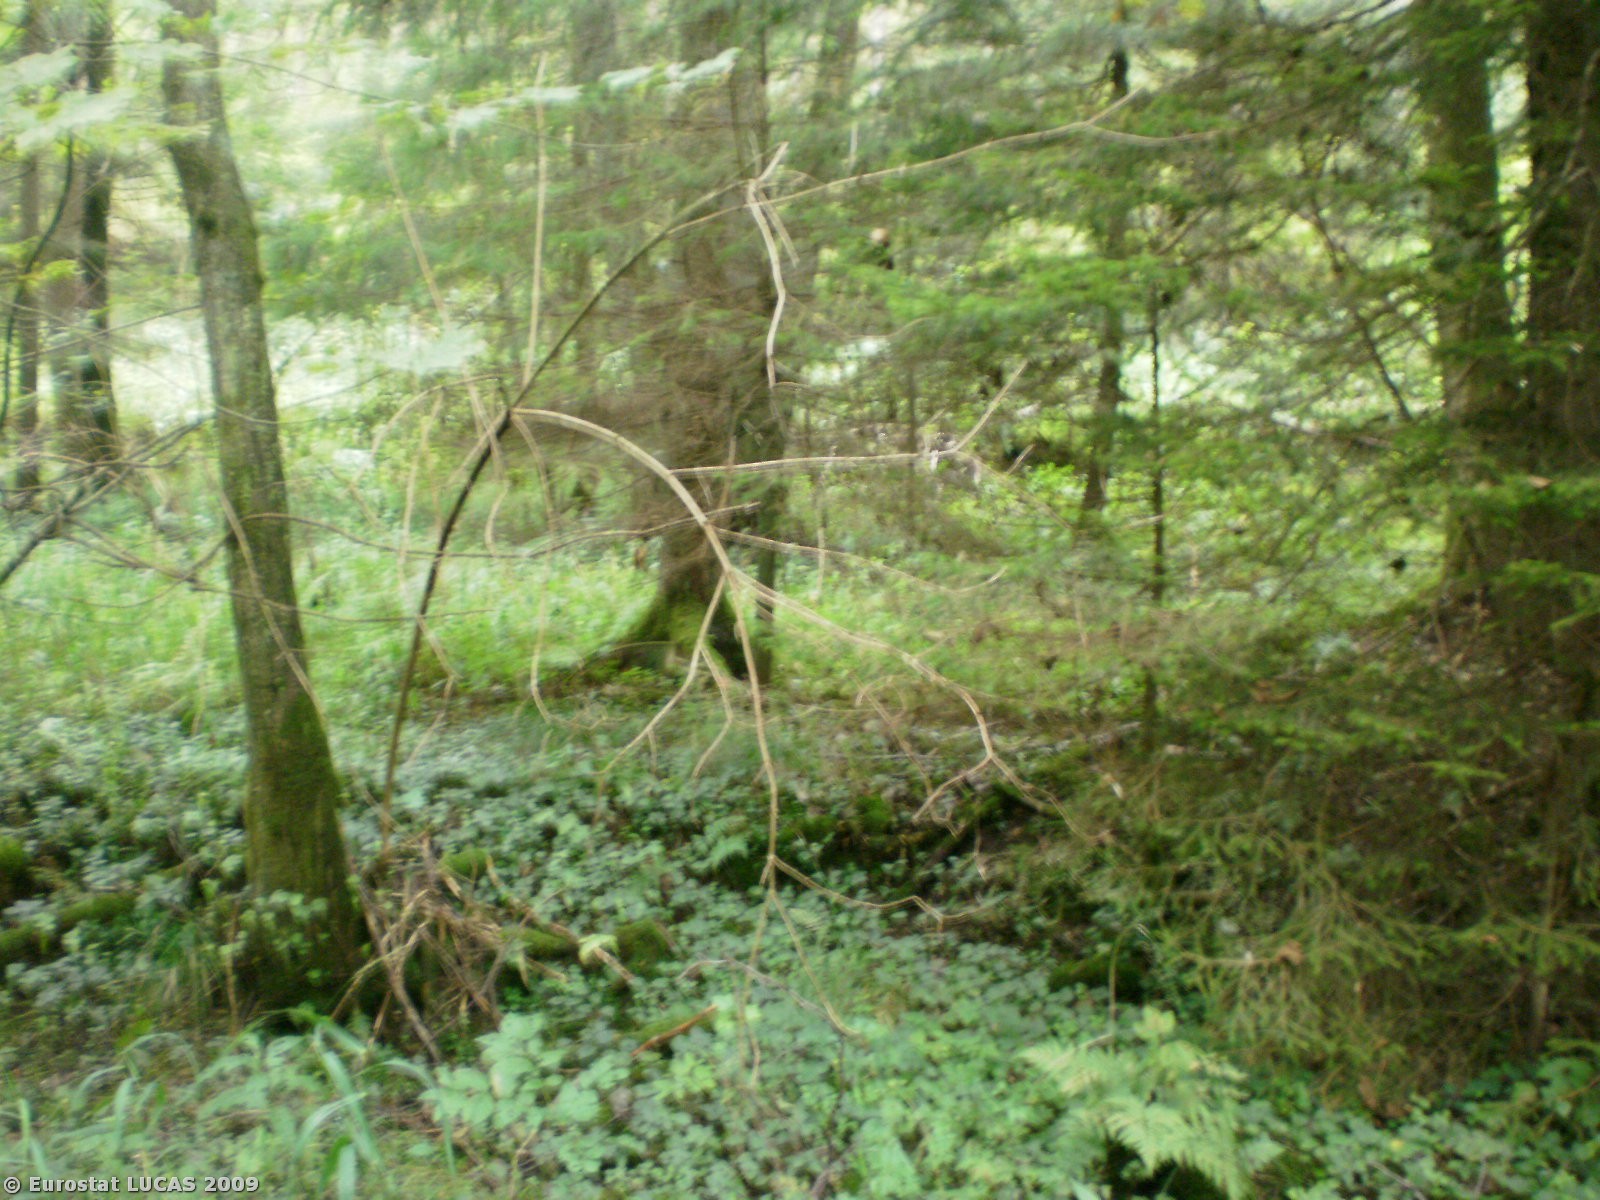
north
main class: Woodland
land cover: Mixed woodland
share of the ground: > 75 %
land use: Nature reserves
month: September
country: BE
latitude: 50.2438
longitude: 5.6094
